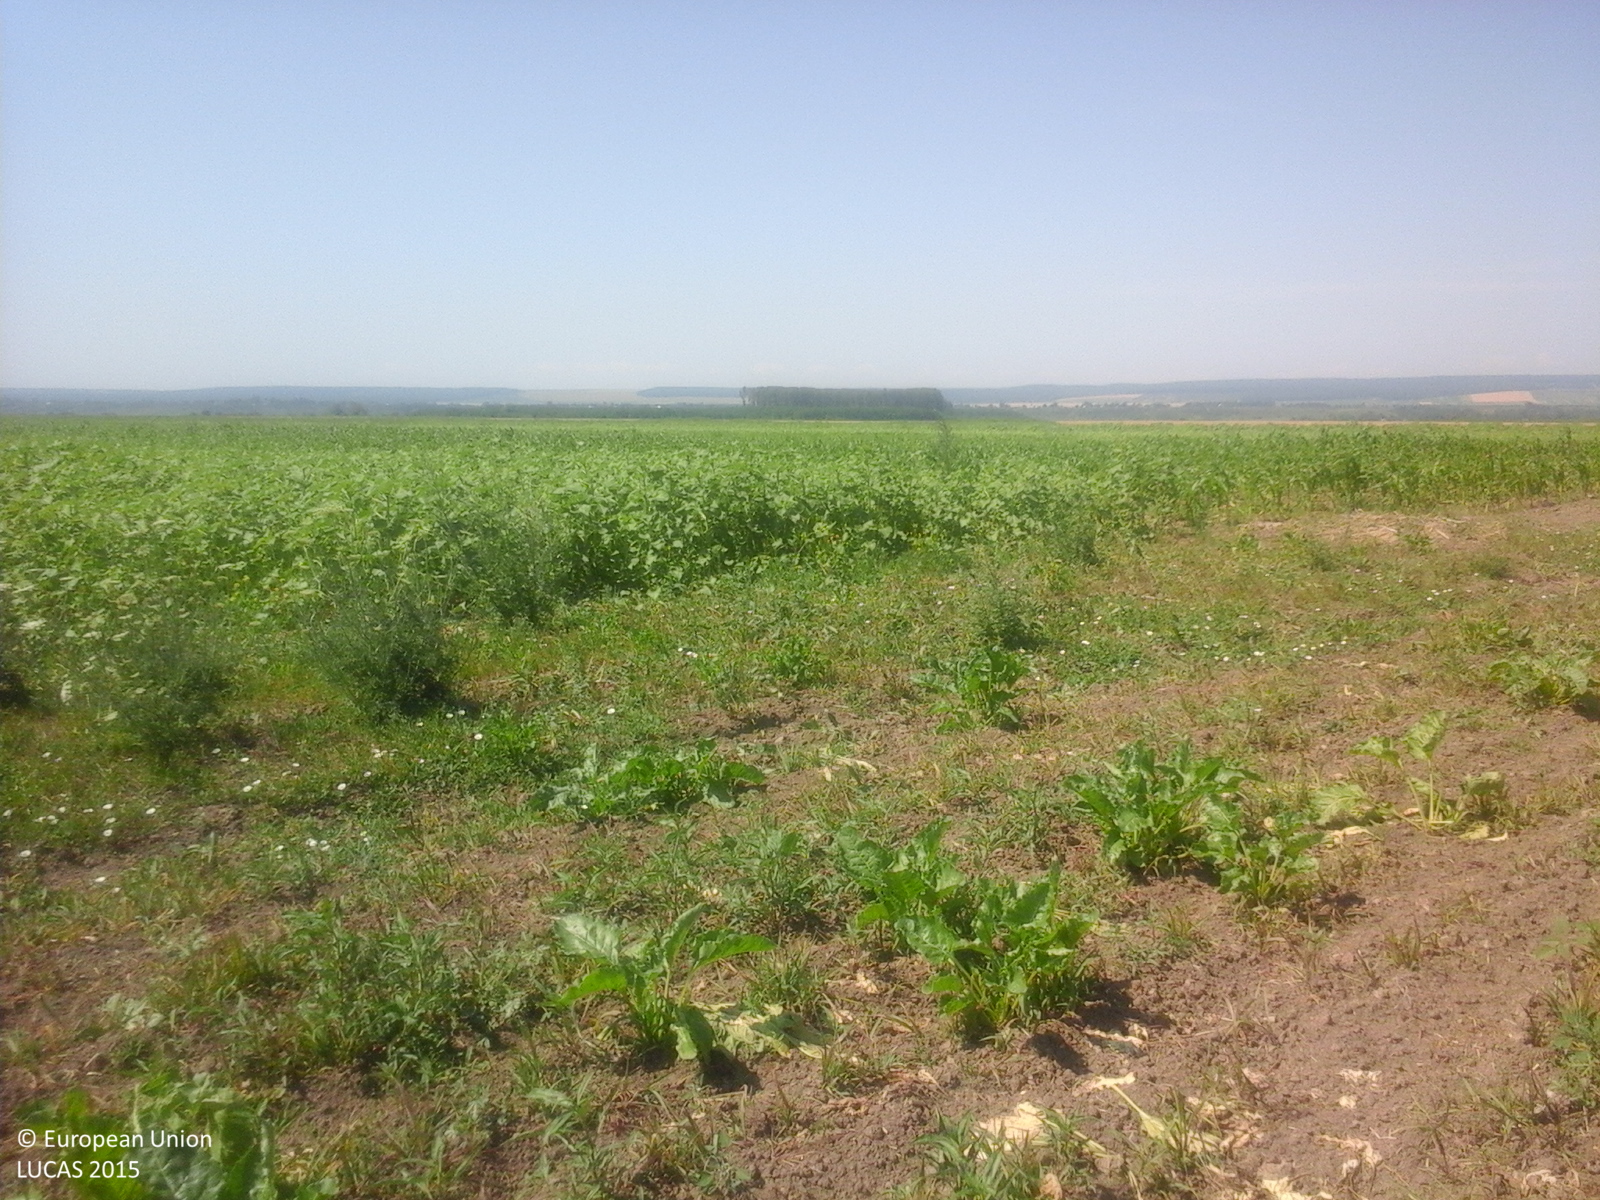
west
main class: Cropland
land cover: Sugar beet
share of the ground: 50 - 75 %
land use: Agriculture (excluding fallow land and kitchen gardens)
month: June
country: RO
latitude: 47.1986
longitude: 26.7931
